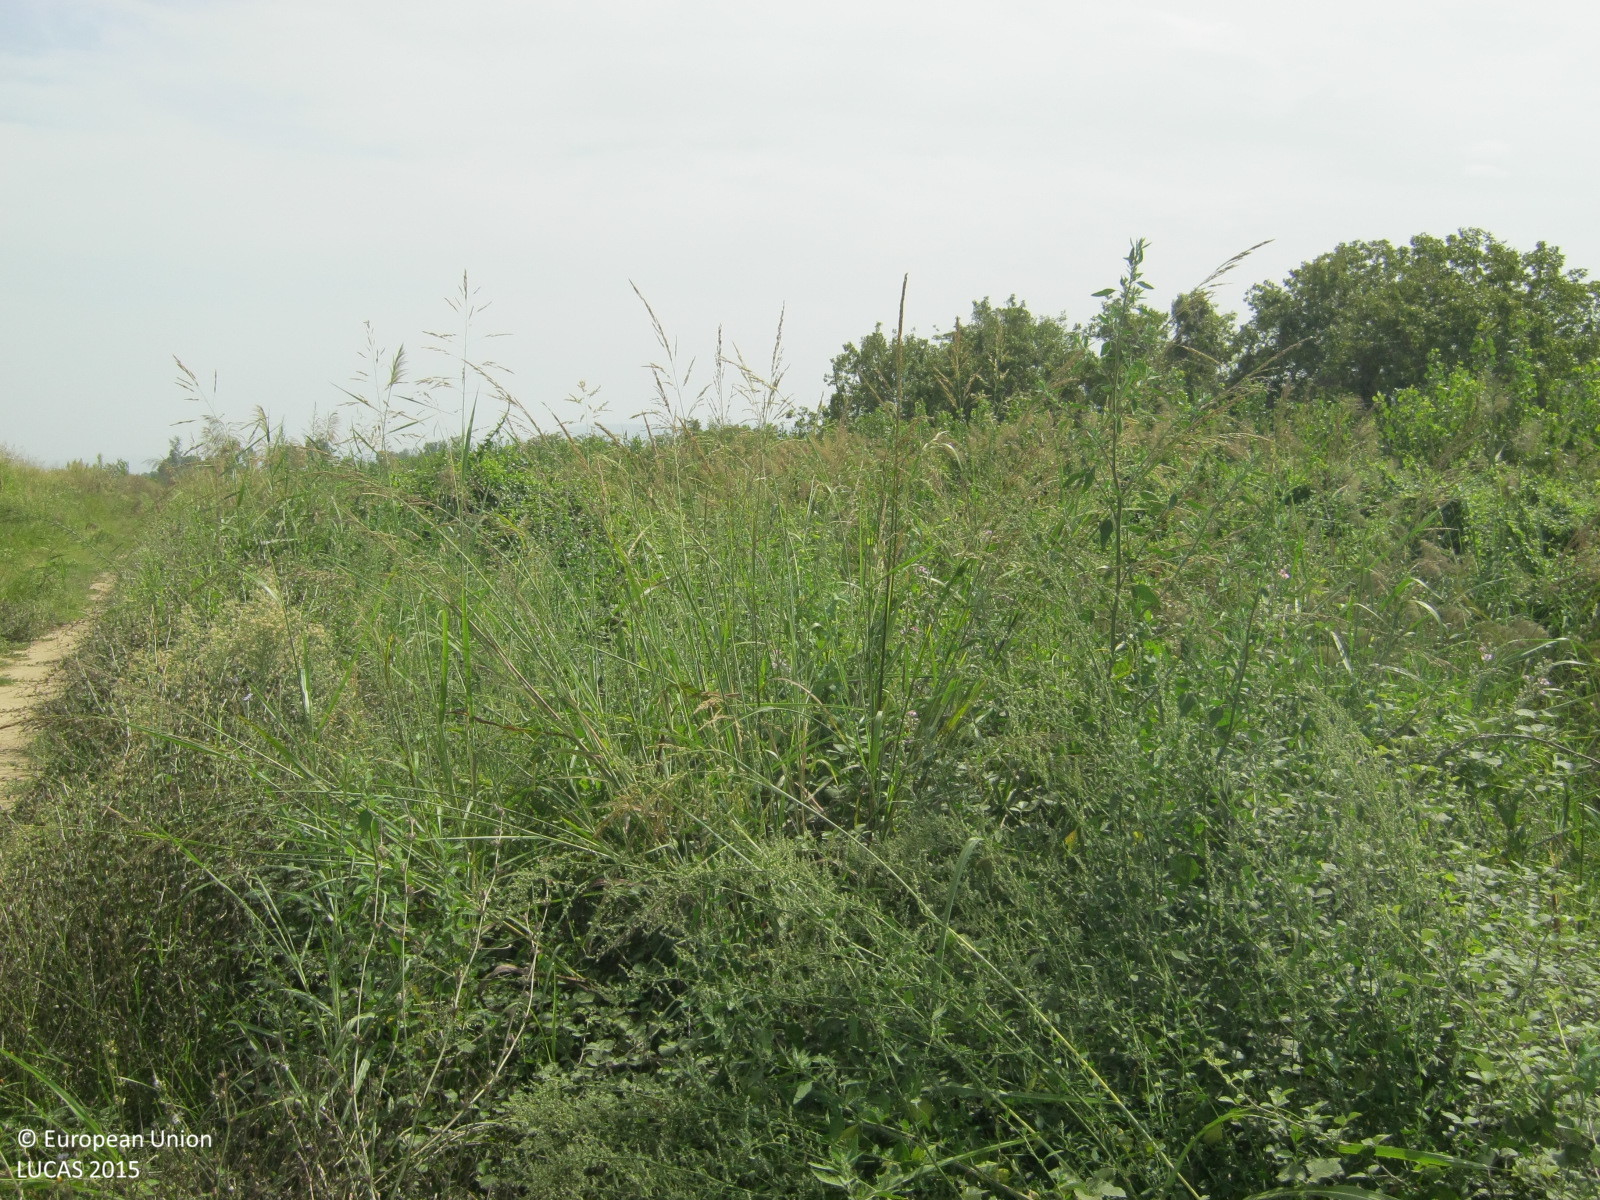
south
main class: Woodland
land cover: Broadleaved woodland
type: floodplain forest
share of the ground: 50 - 75 %
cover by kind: broadleaved forest trees 70 %, herbaceous plants 20 %, shrubs 10 %
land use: Forestry
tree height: < 5 m
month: September
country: GR
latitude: 41.0971
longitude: 23.2919
